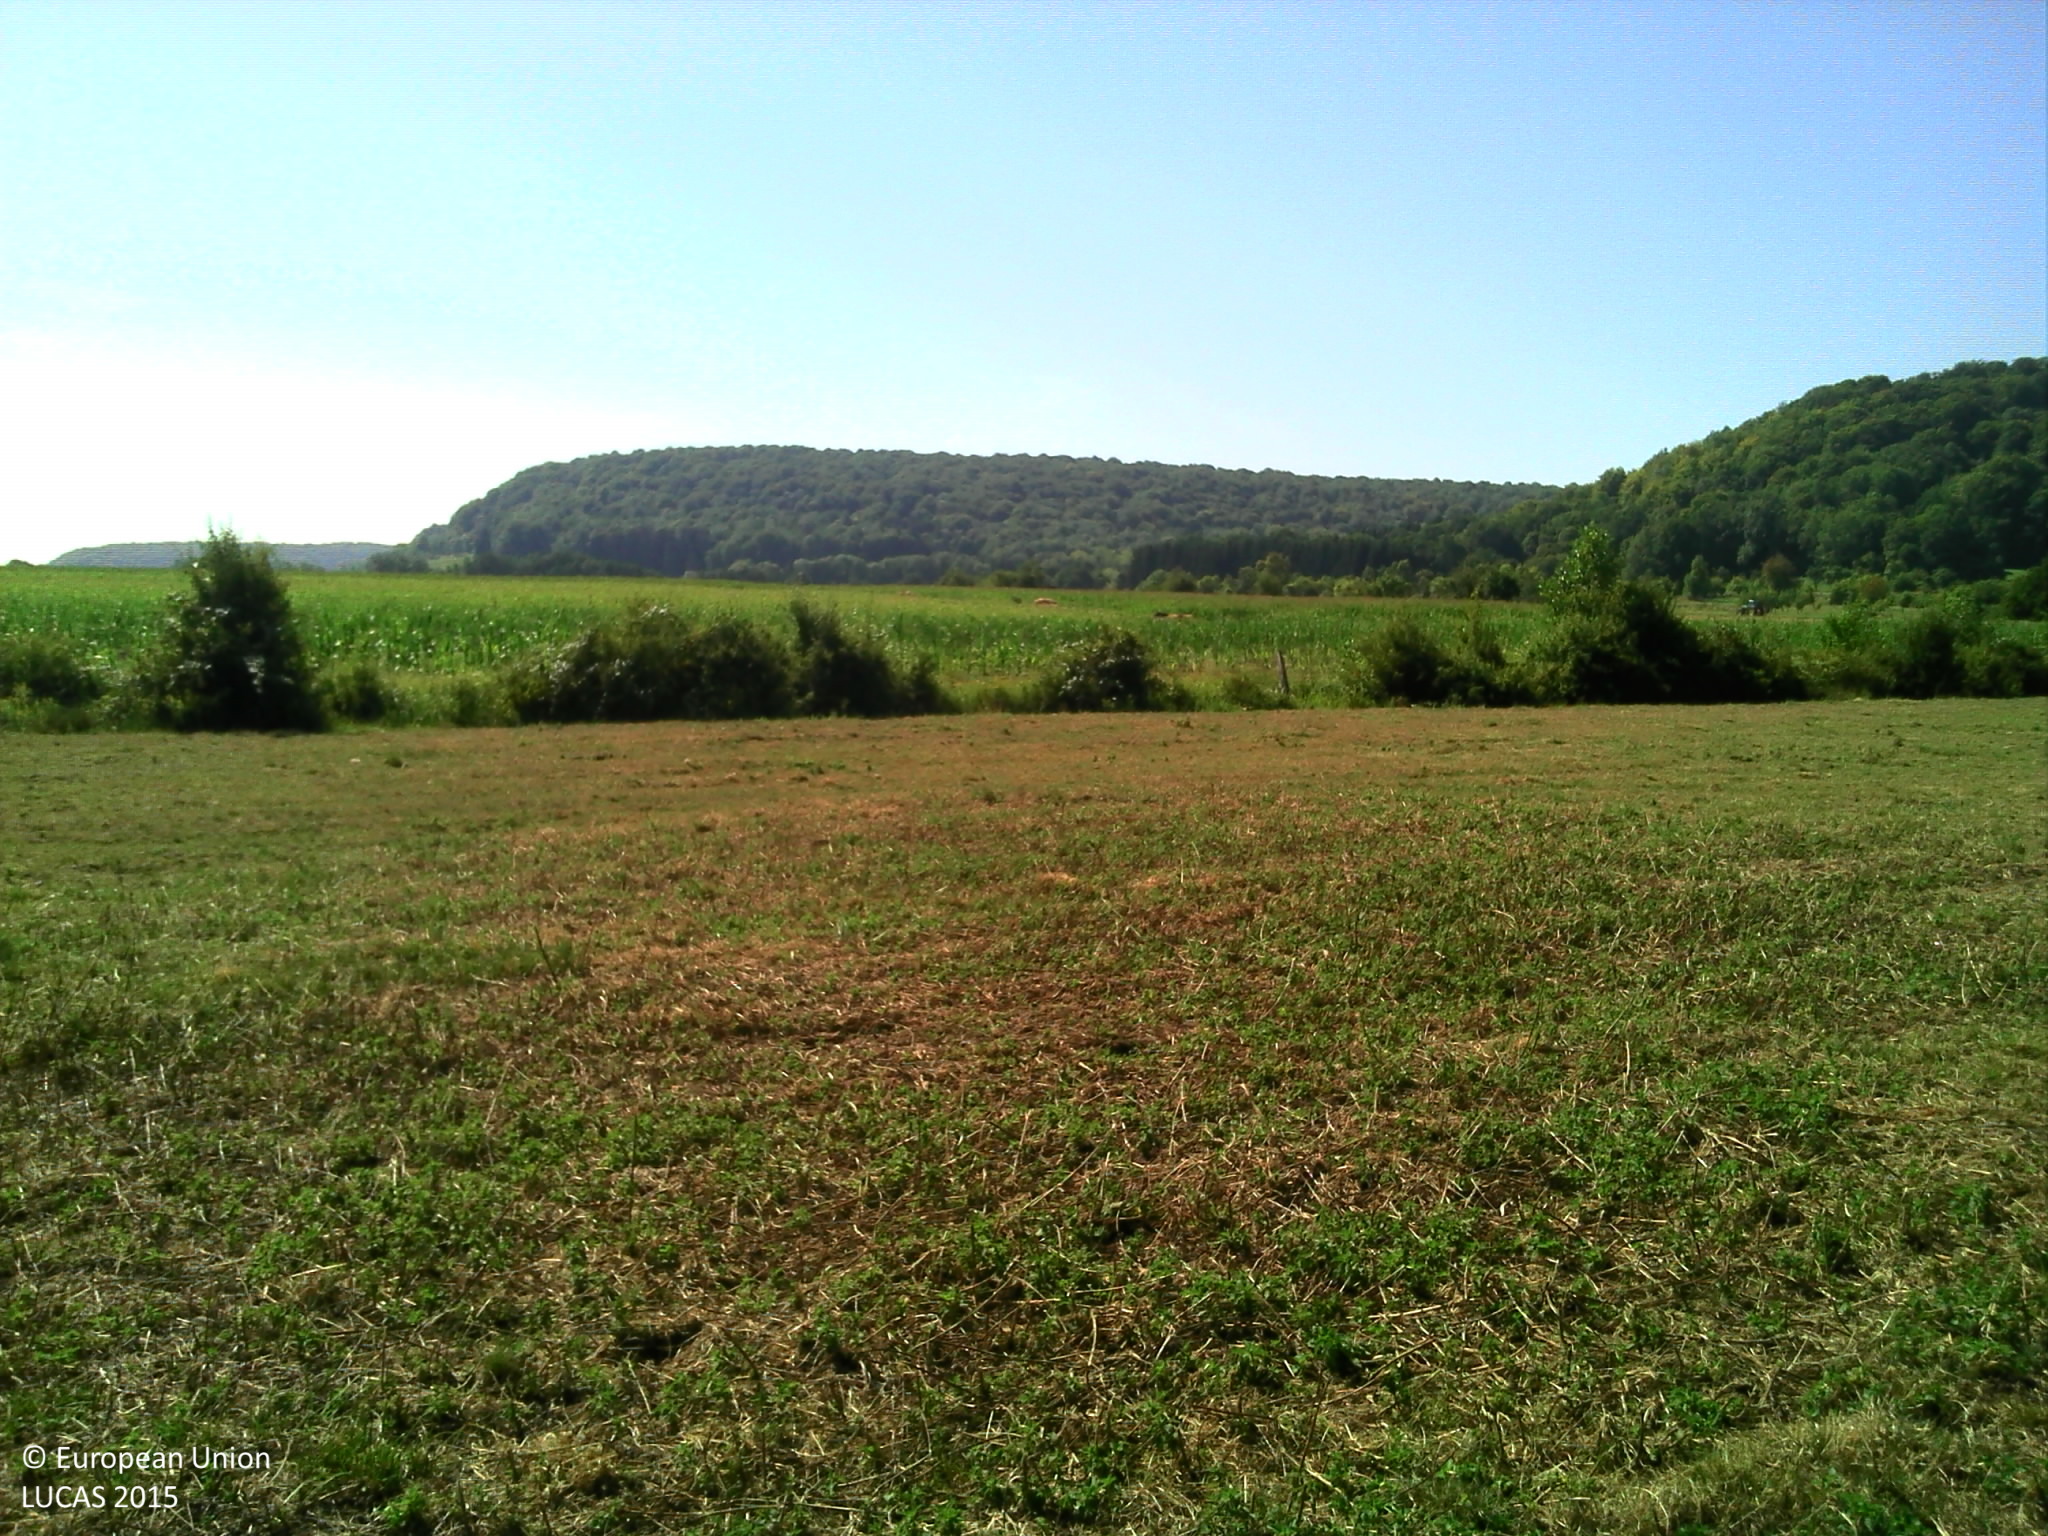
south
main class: Grassland
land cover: Grassland without tree/shrub cover
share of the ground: > 75 %
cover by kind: herbaceous plants 100 %
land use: Agriculture (excluding fallow land and kitchen gardens)
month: August
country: FR
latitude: 49.4496
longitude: 5.1286
